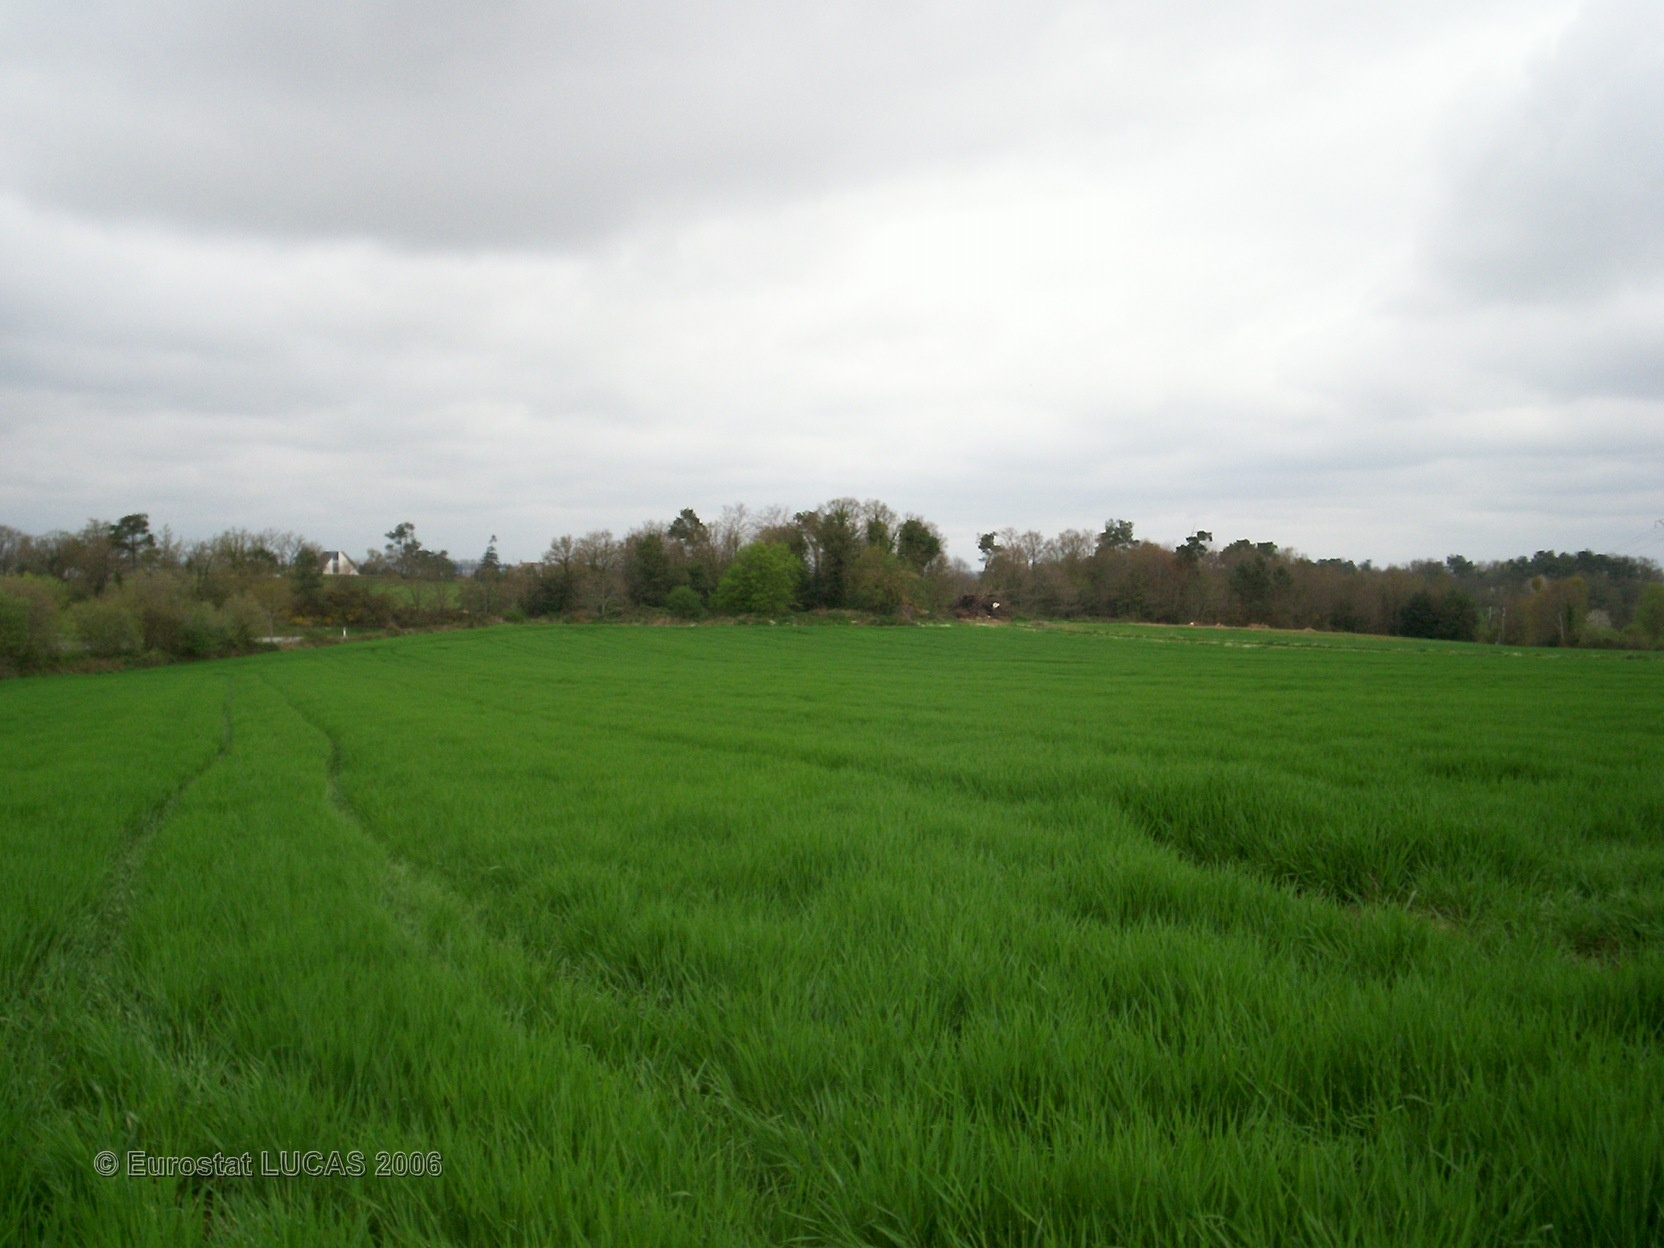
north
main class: Cropland
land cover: Barley
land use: Agriculture (excluding fallow land and kitchen gardens)
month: April
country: FR
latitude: 48.0409
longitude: -2.3029
